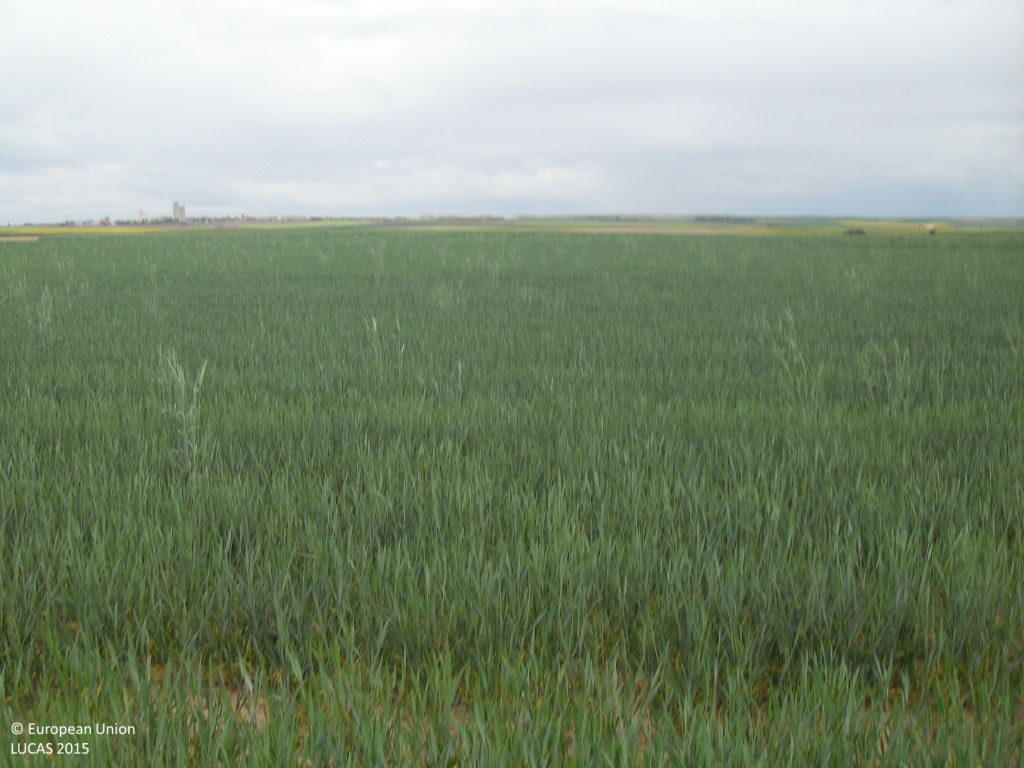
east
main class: Cropland
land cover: Common wheat
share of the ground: > 75 %
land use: Agriculture (excluding fallow land and kitchen gardens)
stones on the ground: 10 - 25 %
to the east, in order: Common wheat; Grass margins; Rye; Barley; Other bare soil; Barley
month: April
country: ES
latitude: 40.8861
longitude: -5.2475
